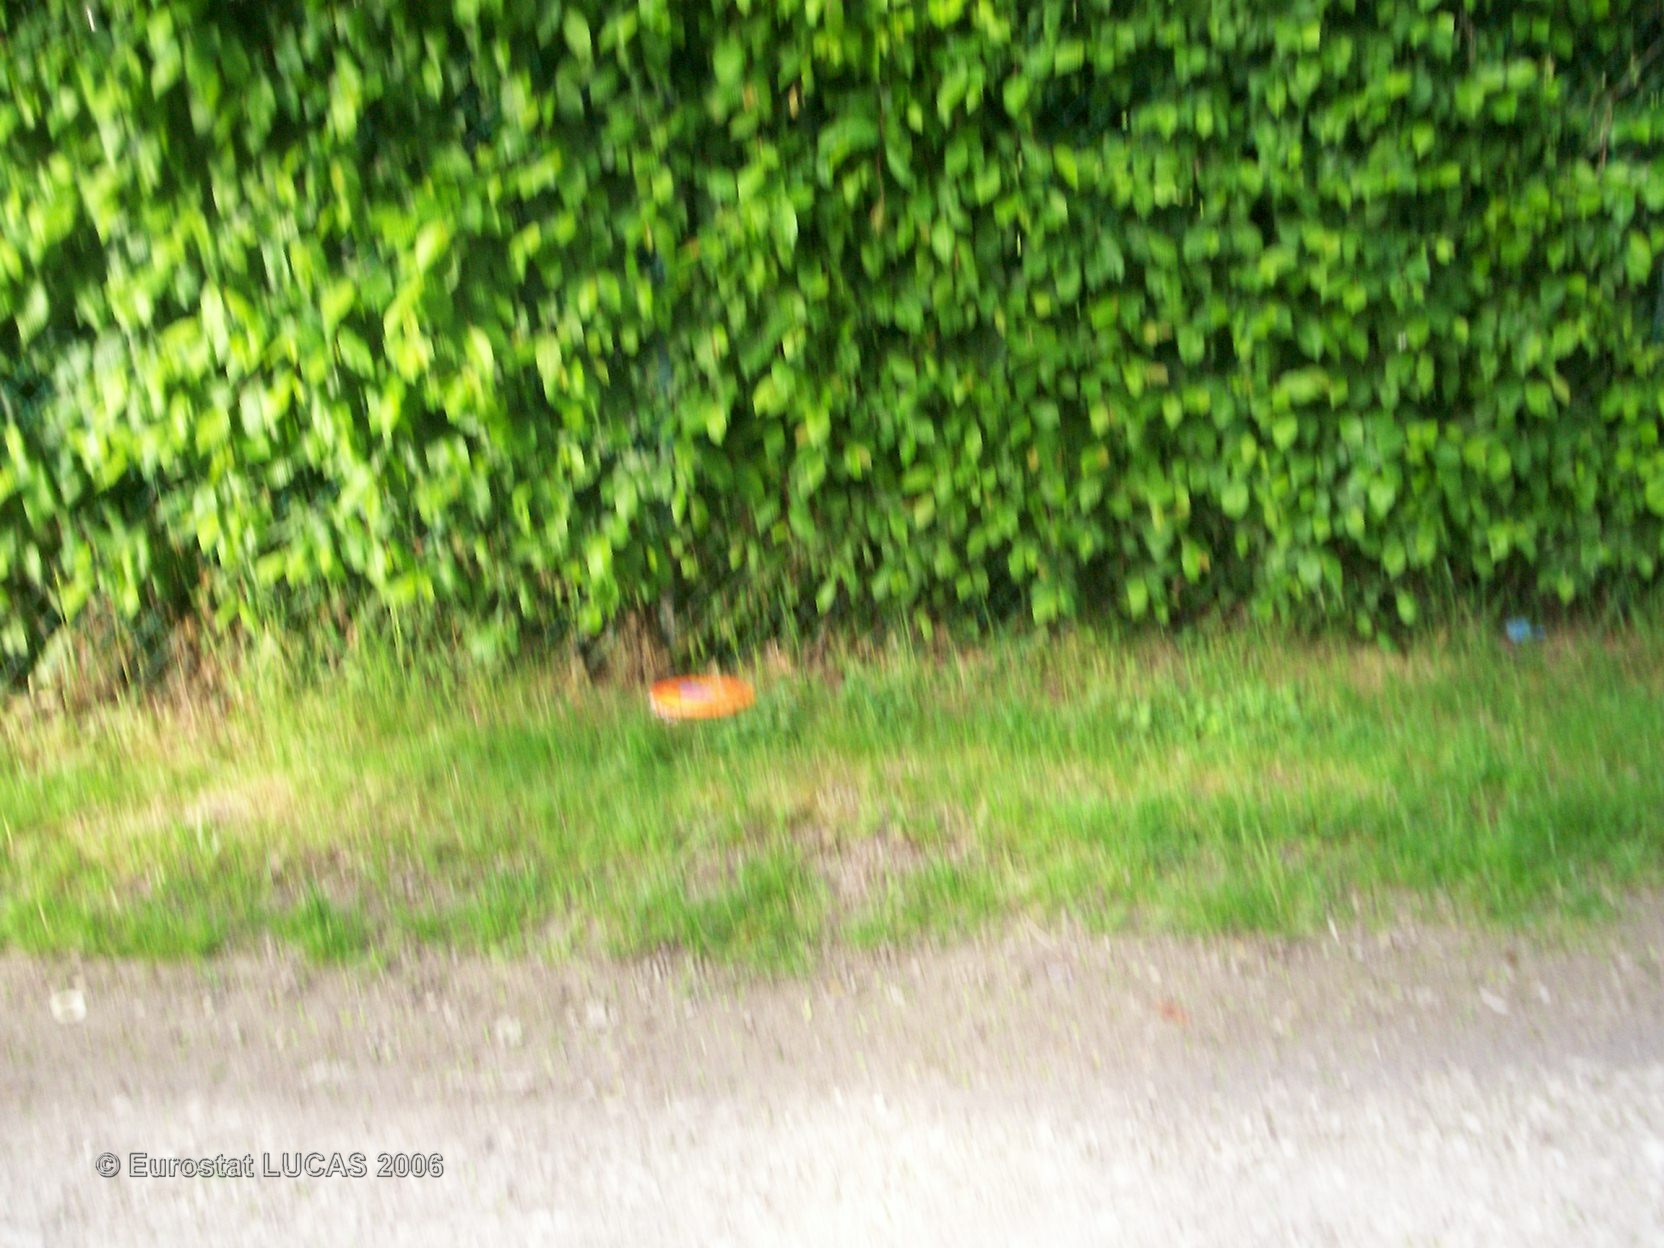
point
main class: Grassland
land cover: Grassland with sparse tree/shrub cover
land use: Residential
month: May
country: FR
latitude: 48.5854
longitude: 2.8195
